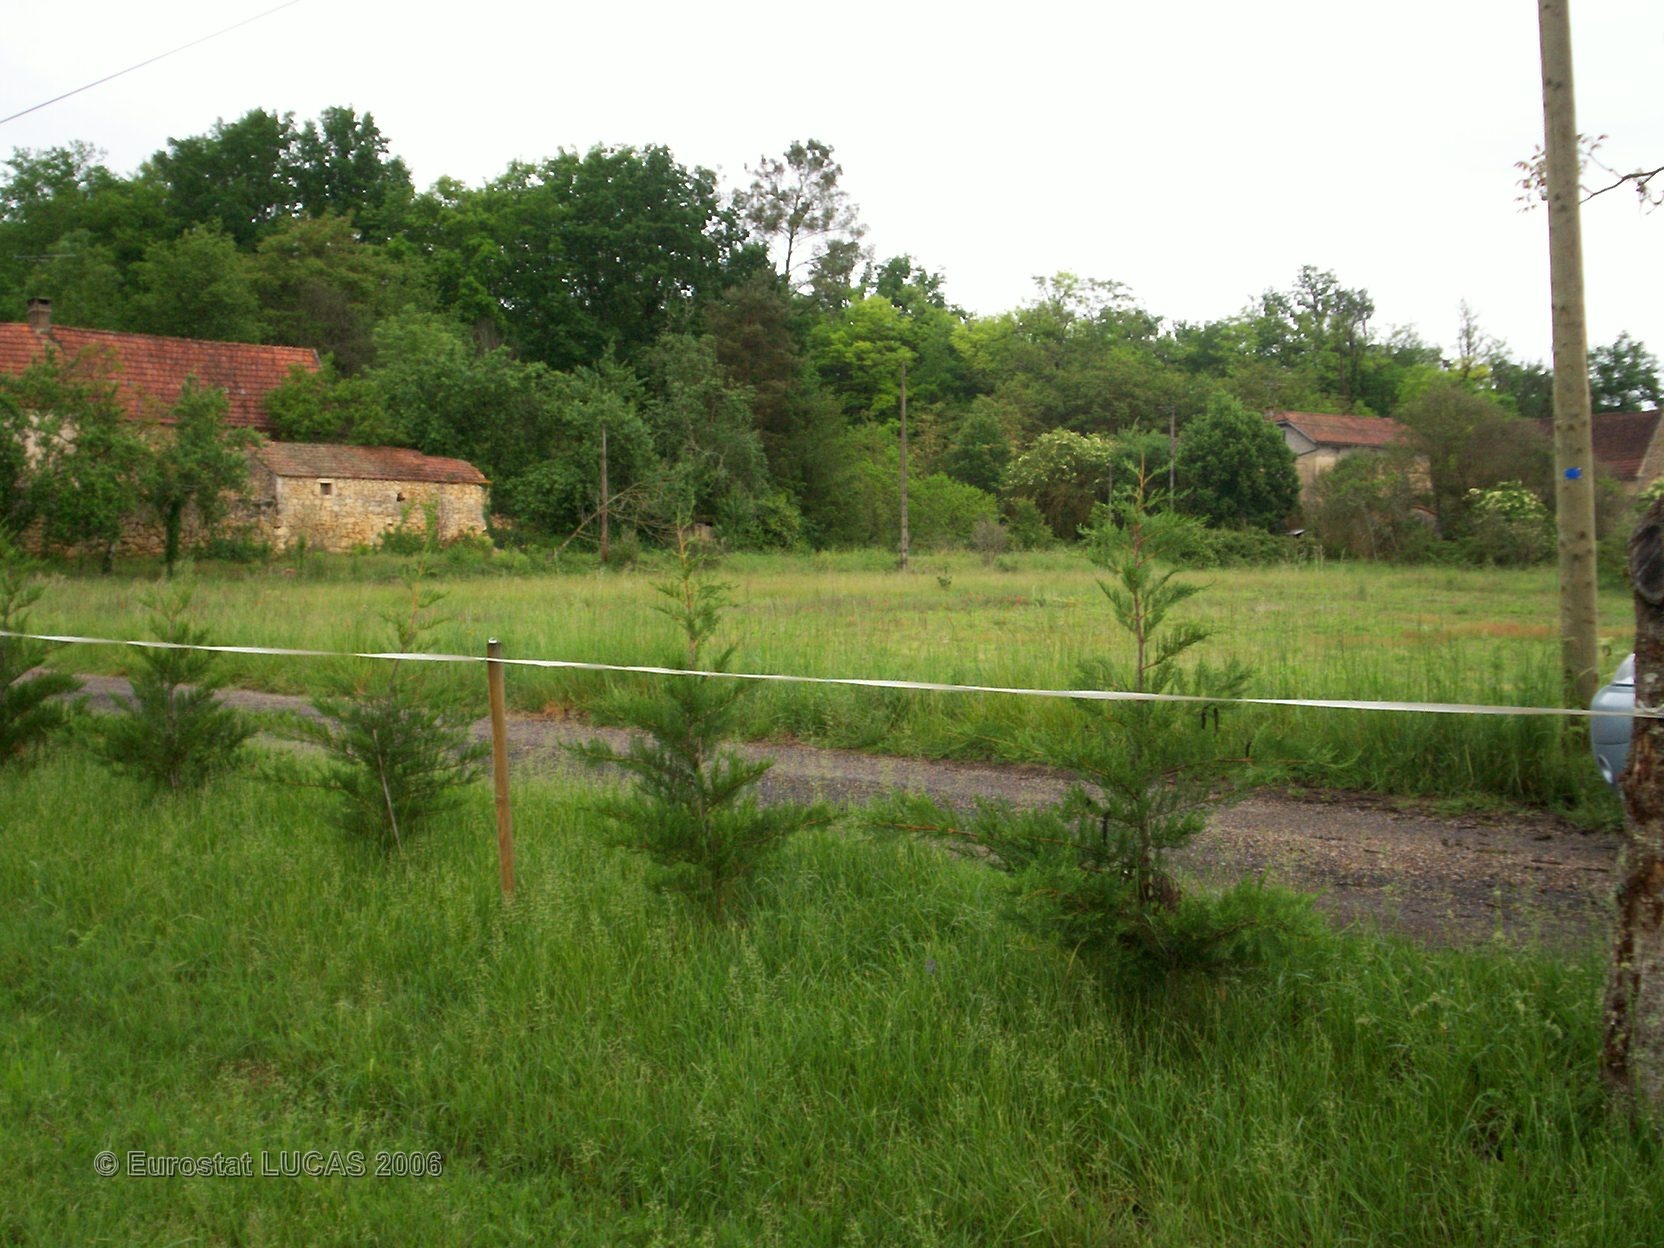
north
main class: Grassland
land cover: Grassland without tree/shrub cover
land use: Agriculture (excluding fallow land and kitchen gardens)
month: May
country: FR
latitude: 44.7876
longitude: 1.3635
